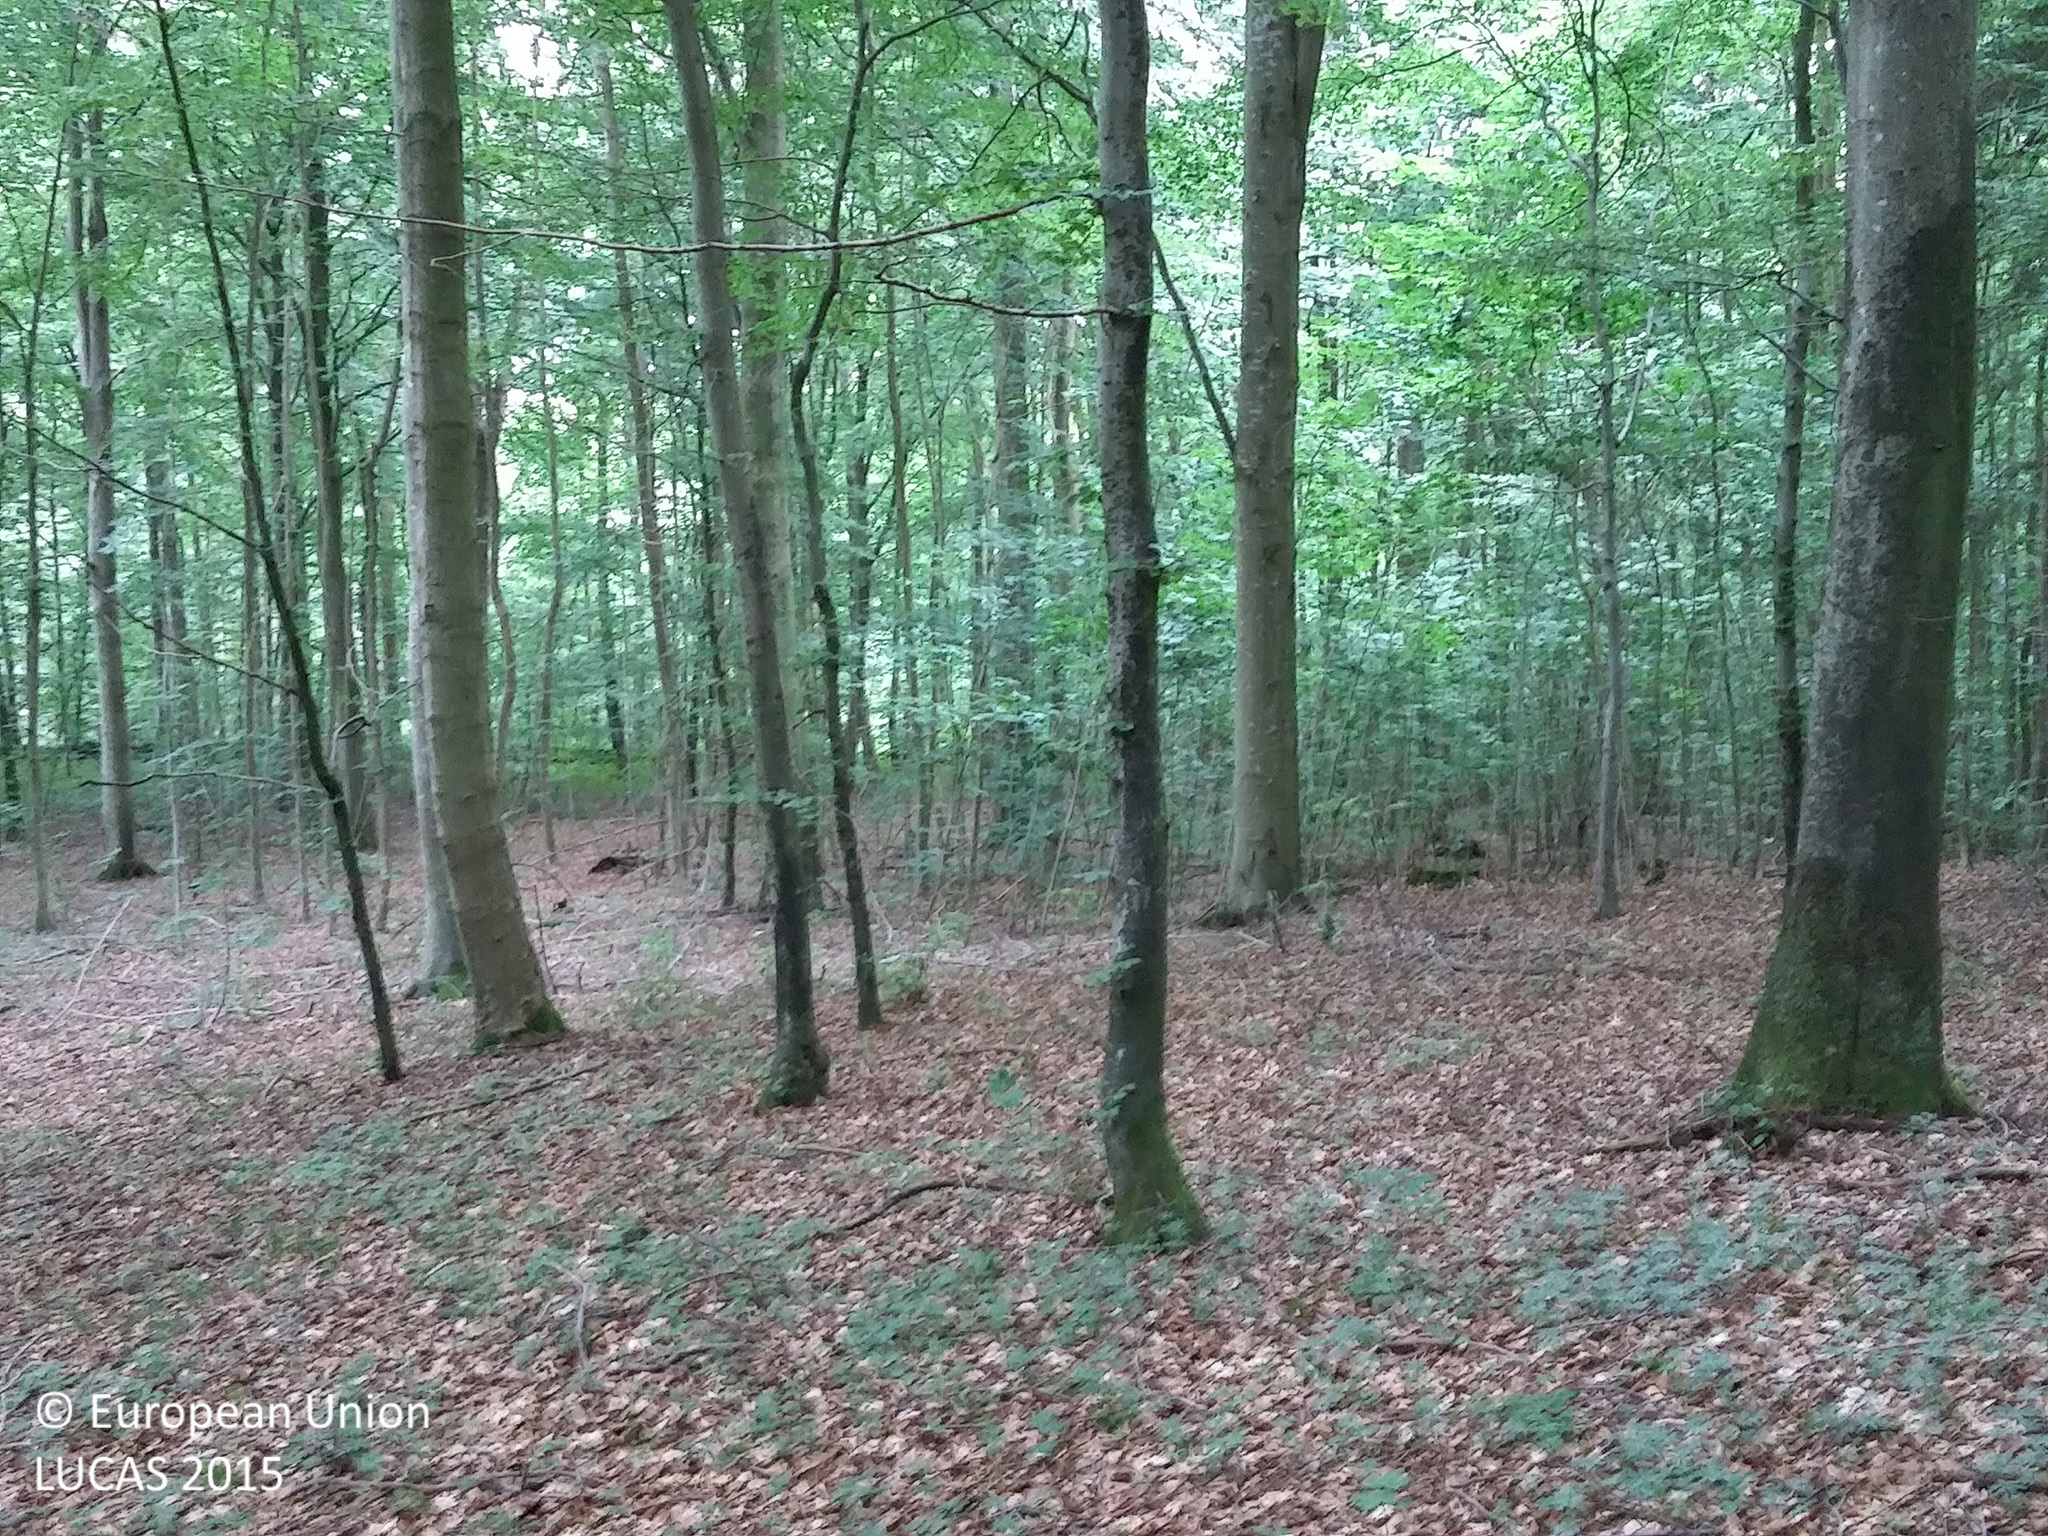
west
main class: Woodland
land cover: Broadleaved woodland
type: beech forest
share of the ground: > 75 %
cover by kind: broadleaved forest trees 80 %, herbaceous plants 10 %, unconsolidated bare surface 10 %
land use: Forestry
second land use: Amenities, museums, leisure
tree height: > 5 m
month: July
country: DK
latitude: 55.2765
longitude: 11.7774
